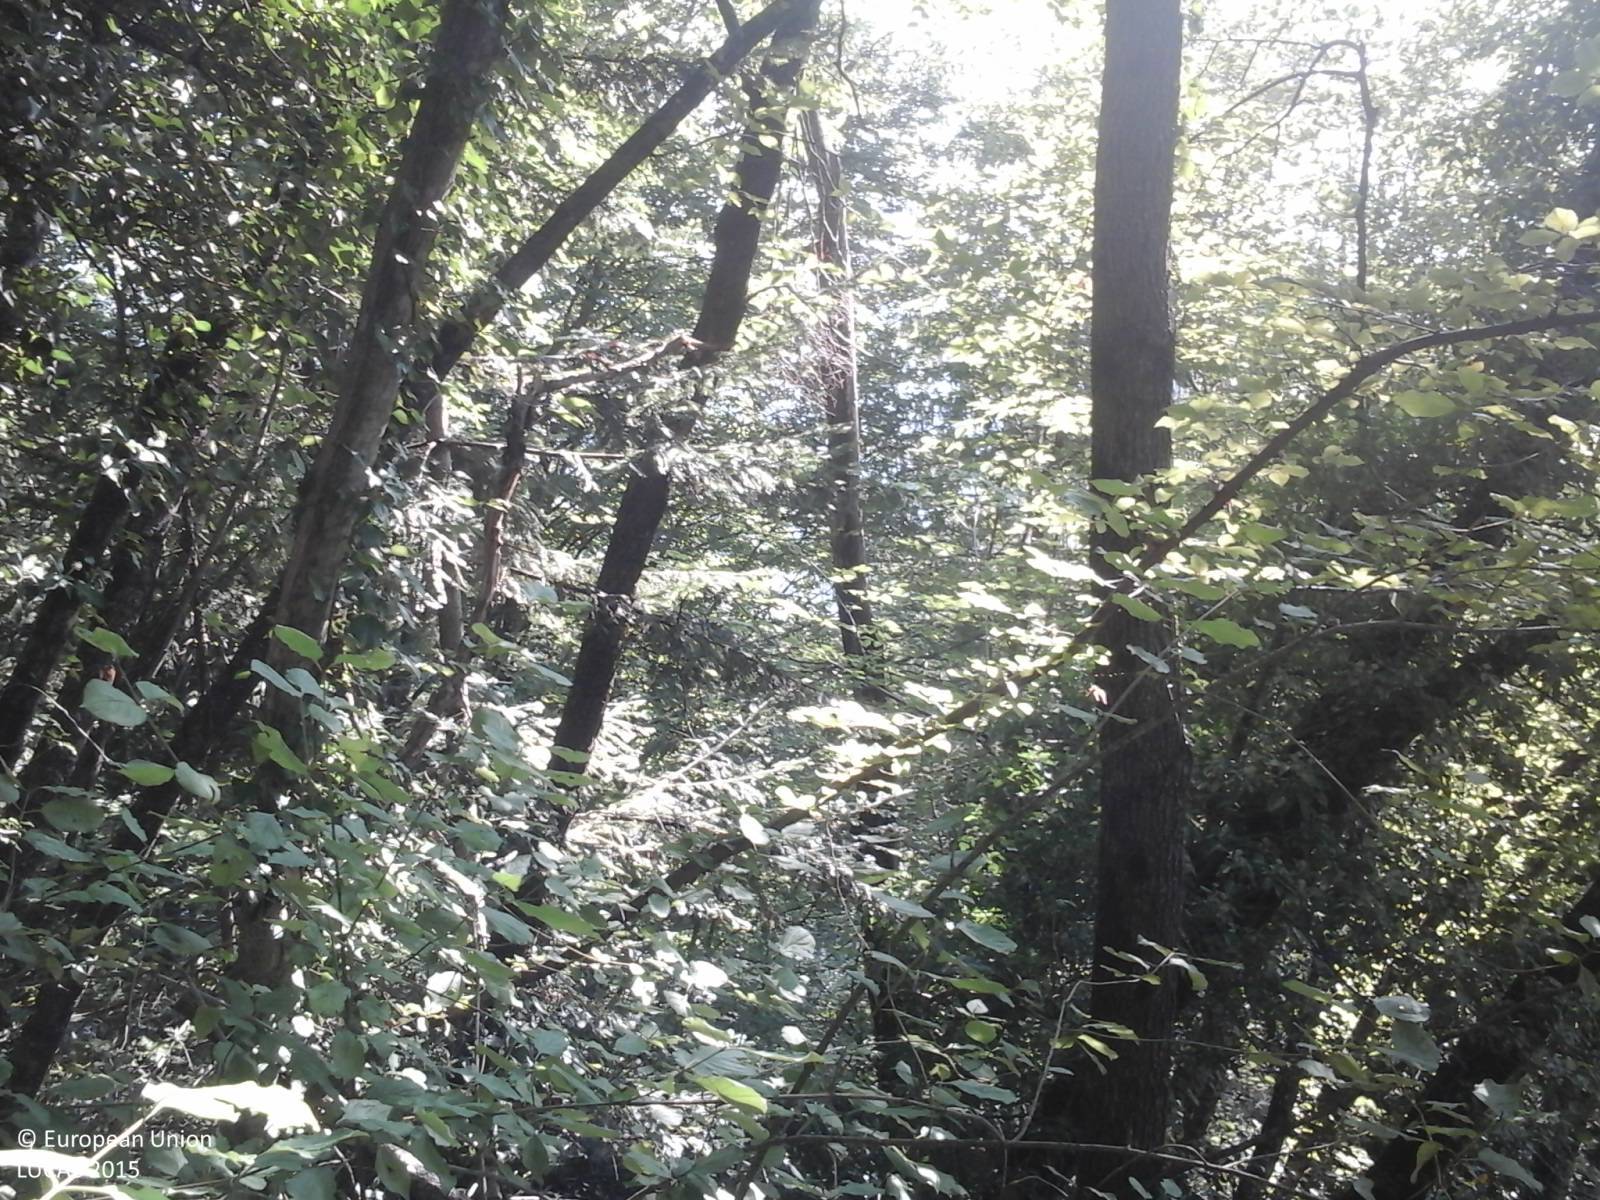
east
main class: Woodland
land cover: Broadleaved woodland
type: beech forest
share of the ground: > 75 %
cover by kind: broadleaved forest trees 80 %, coniferous forest trees 20 %
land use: Forestry
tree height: > 5 m
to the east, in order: Broadleaved woodland; Artificial constructions in urban areas; Shrubland with sparse tree cover; Grassland without tree/shrub cover
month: September
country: IT
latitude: 46.4697
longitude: 13.0574
